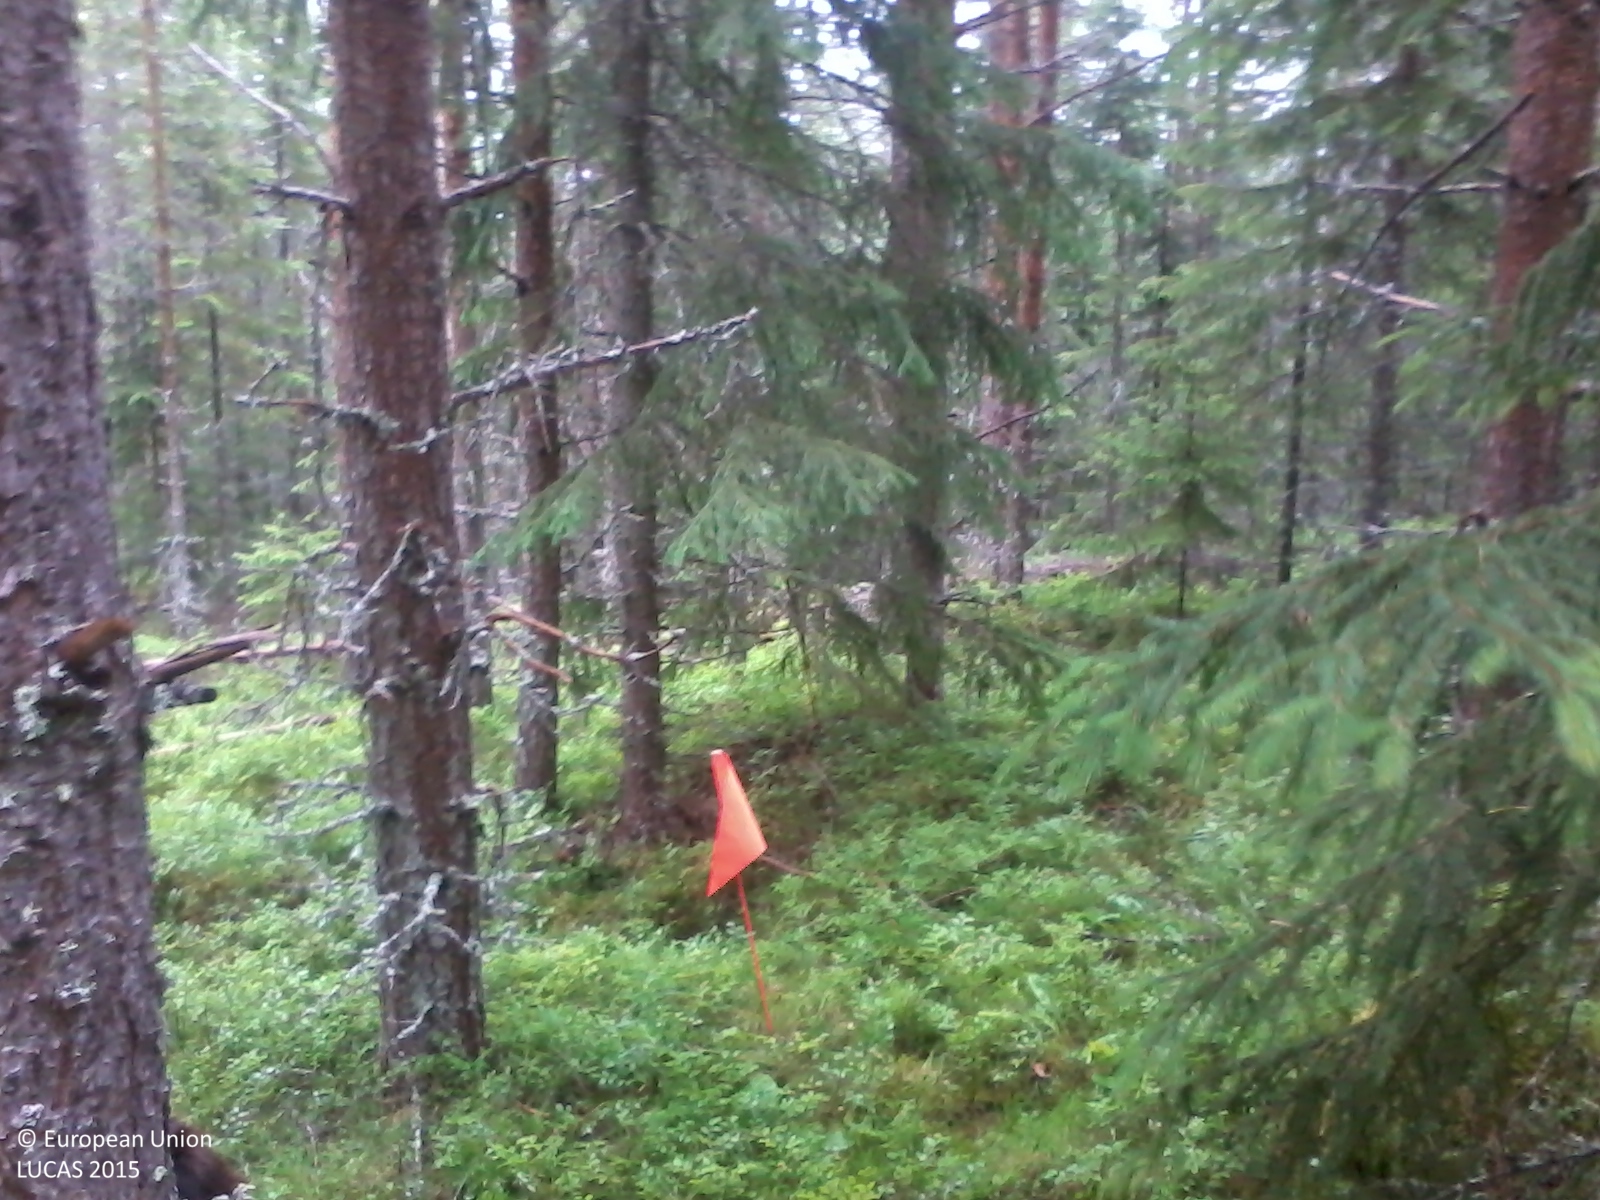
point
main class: Woodland
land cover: Pine dominated coniferous woodland
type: boreal forest
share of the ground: 50 - 75 %
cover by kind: coniferous forest trees 70 %, shrubs 30 %
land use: Forestry
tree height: > 5 m
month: August
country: SE
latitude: 62.8538
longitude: 16.8730
